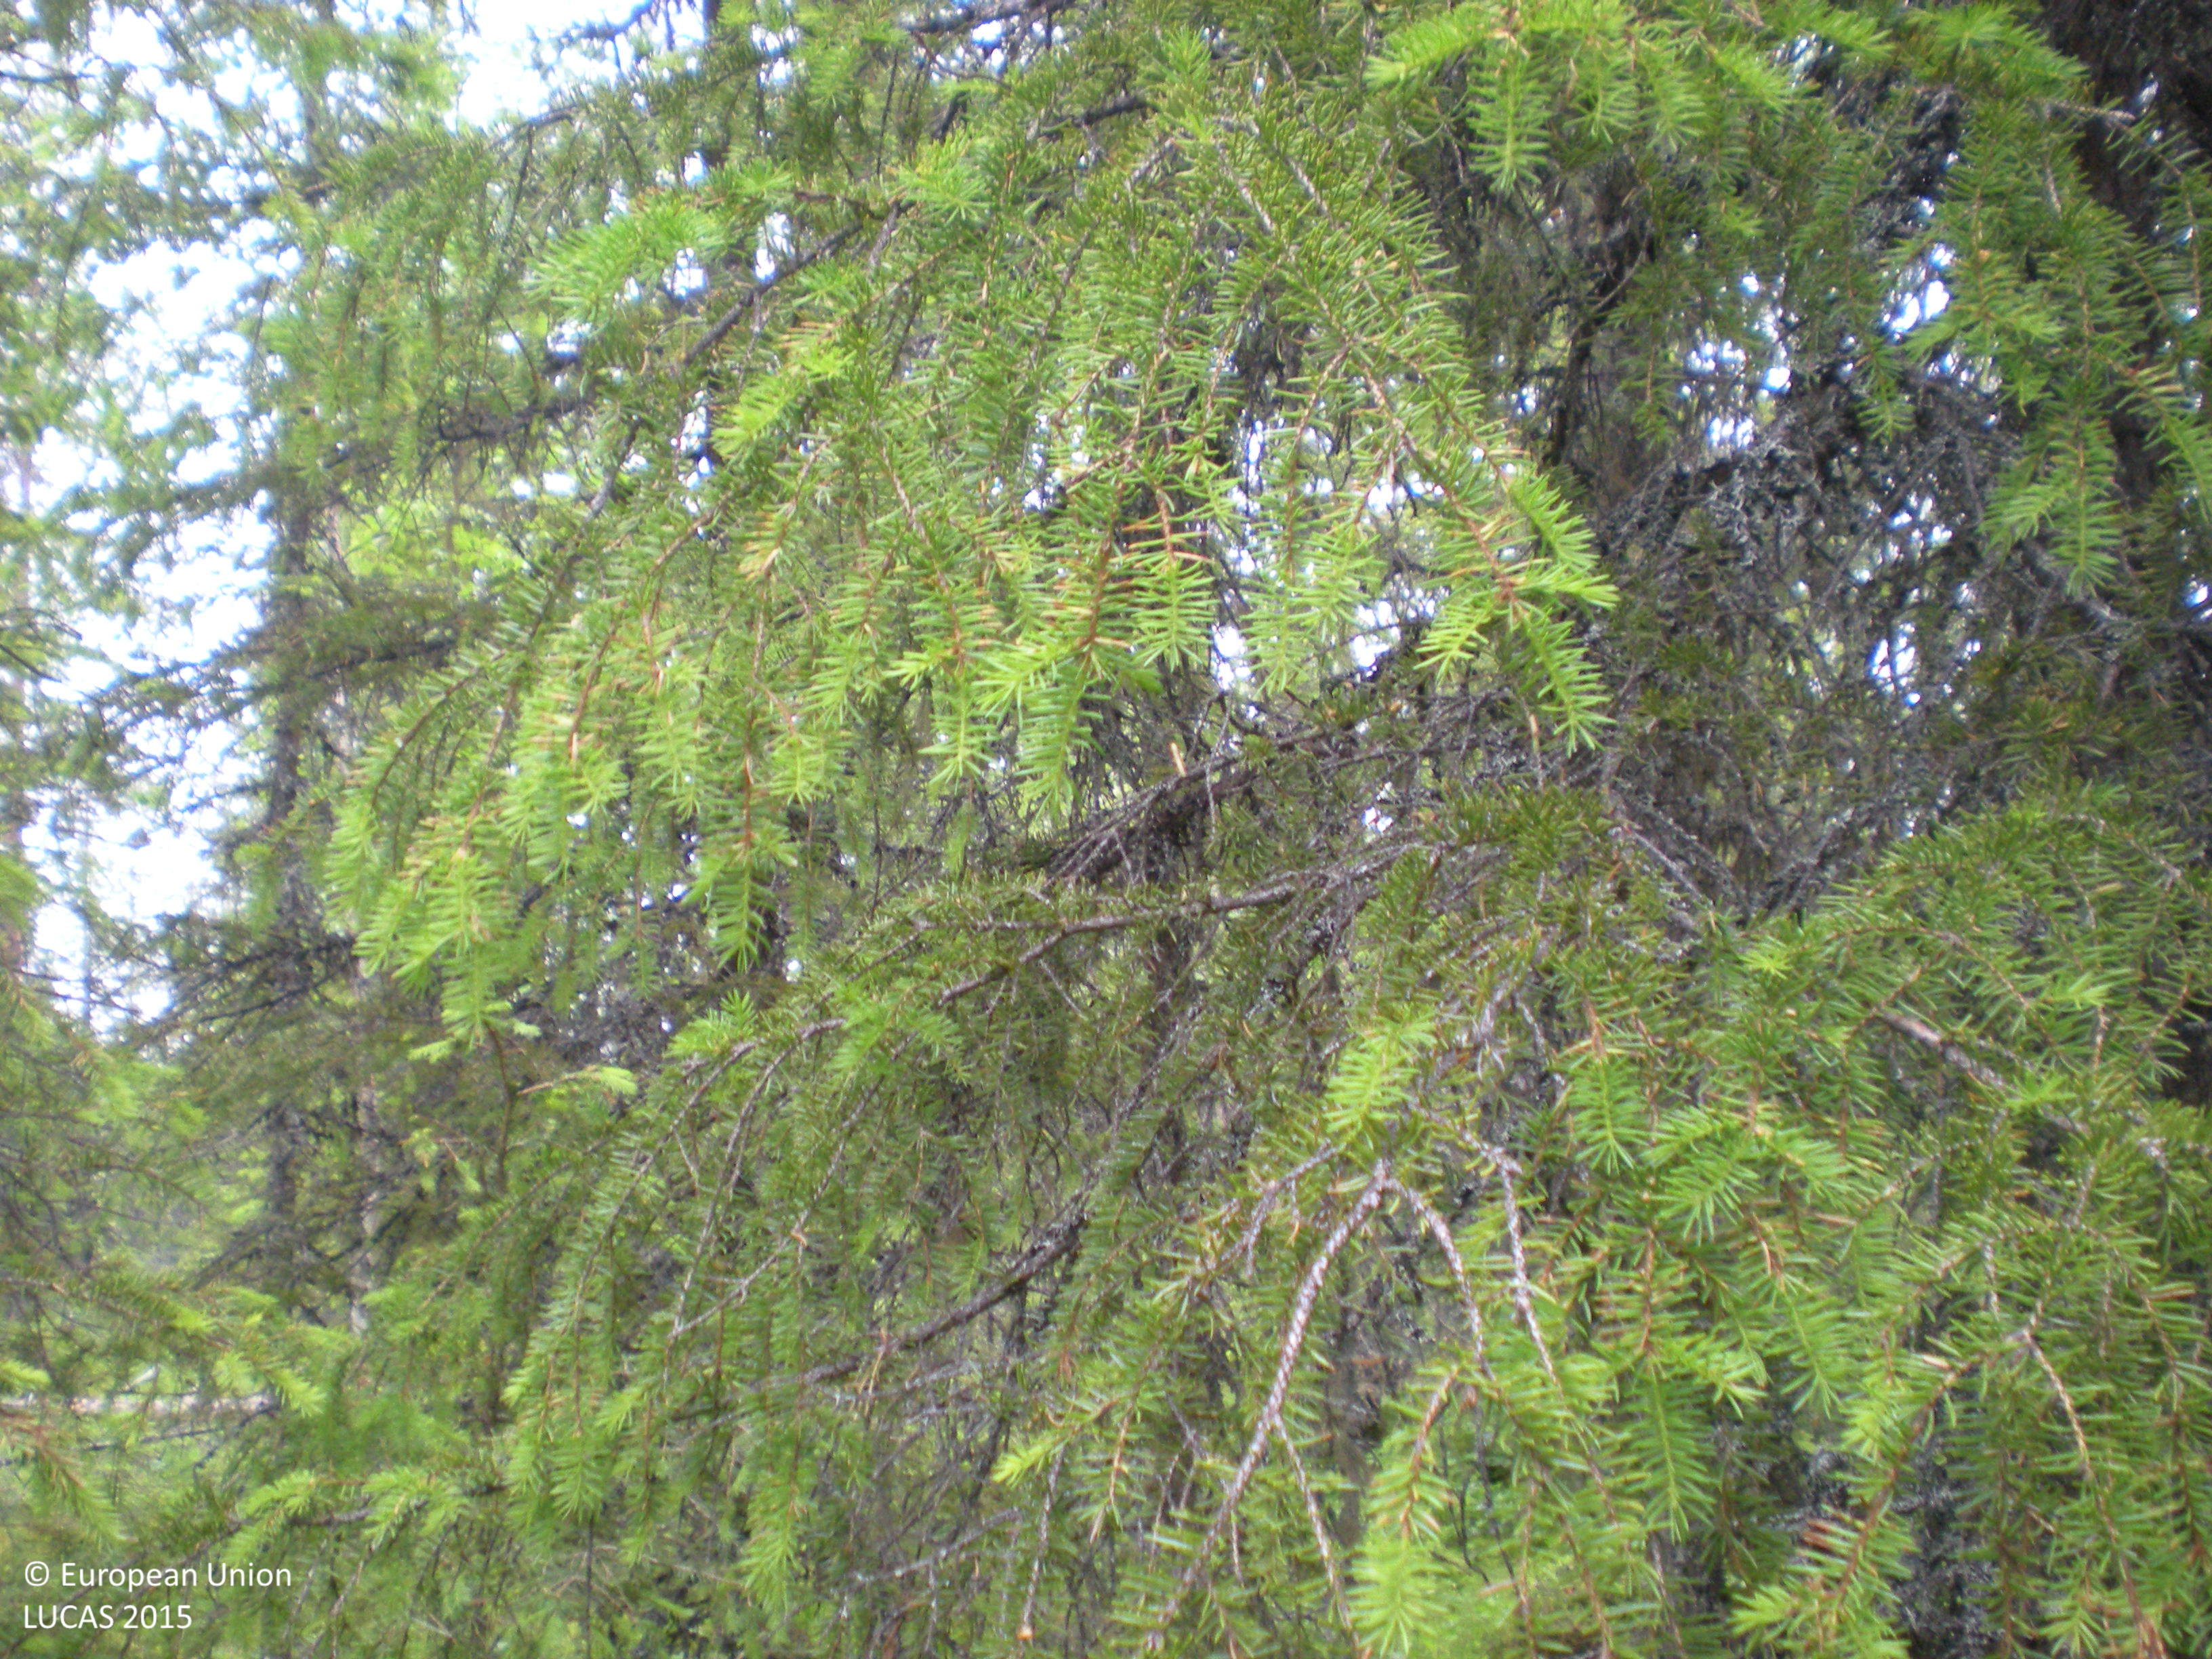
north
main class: Woodland
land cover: Spruce dominated coniferous woodland
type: boreal forest
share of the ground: > 75 %
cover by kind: coniferous forest trees 75 %, lichens and mosses 15 %, herbaceous plants 10 %
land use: Forestry
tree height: > 5 m
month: July
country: SE
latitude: 65.5237
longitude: 17.9845
